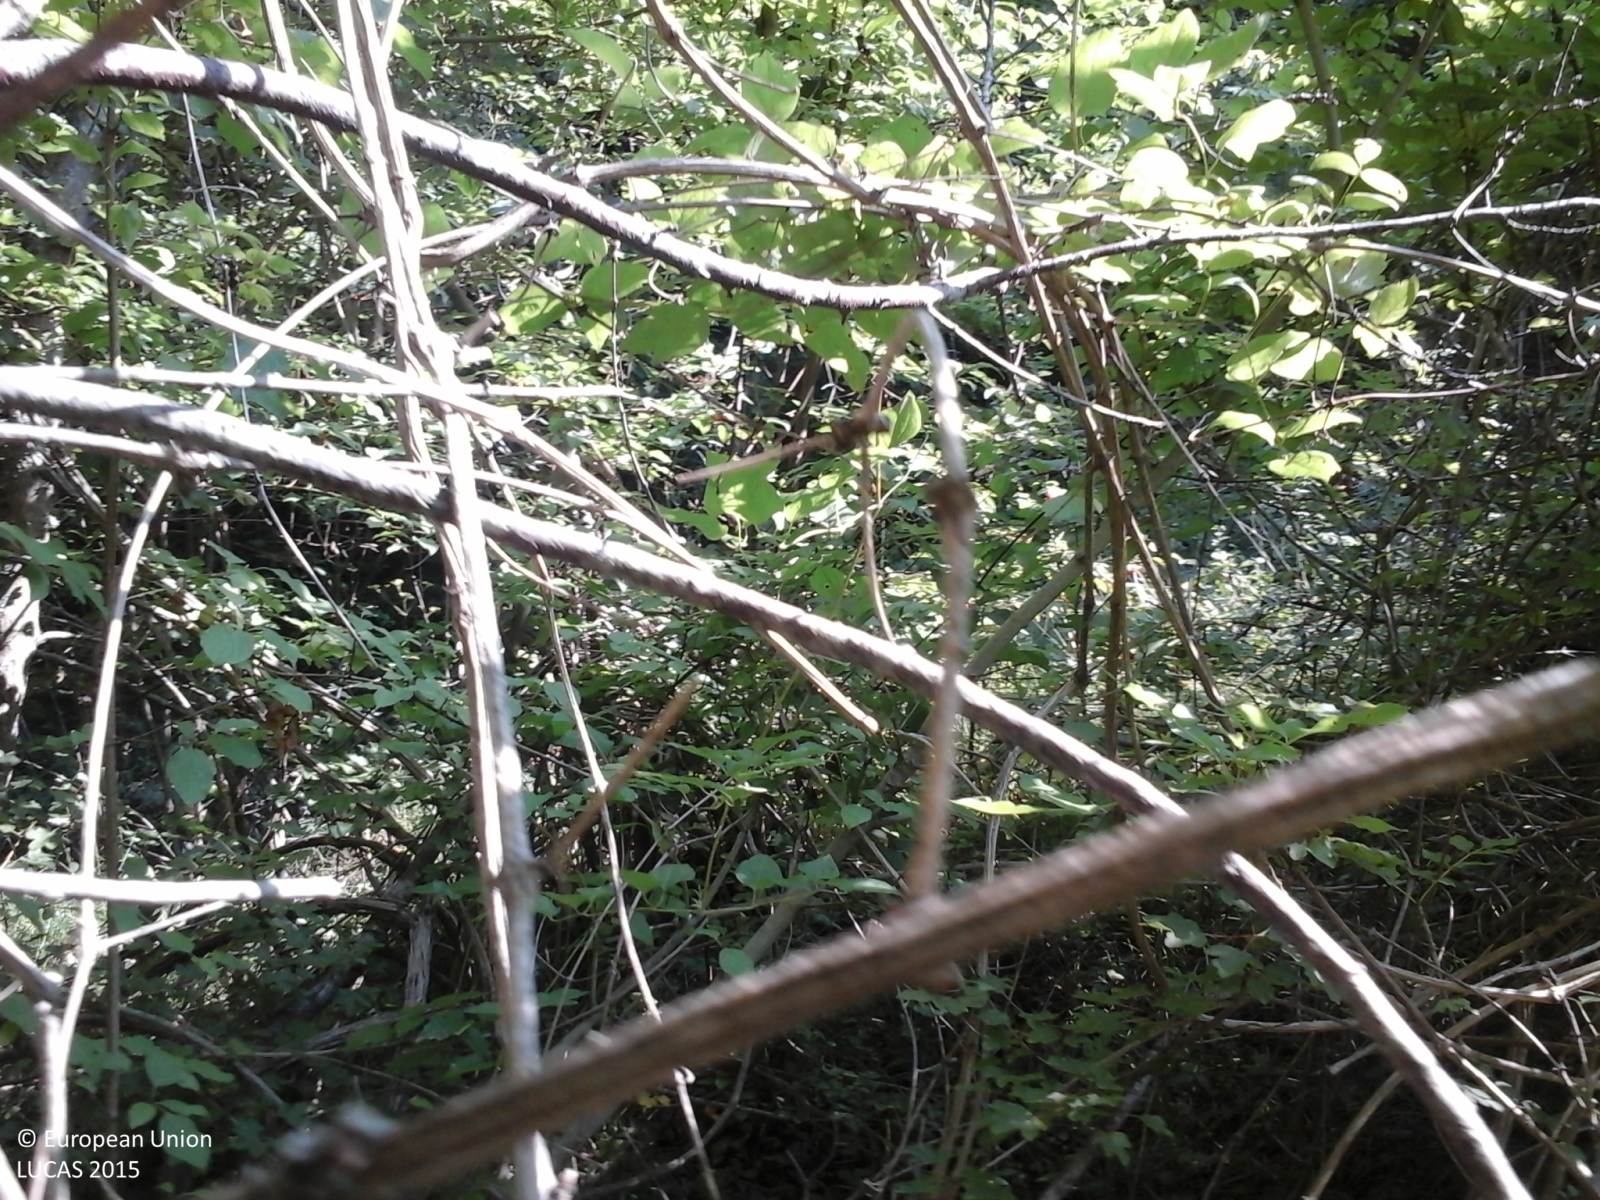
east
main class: Woodland
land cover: Broadleaved woodland
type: thermophilous deciduous forest
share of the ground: > 75 %
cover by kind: broadleaved forest trees 100 %
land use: Forestry
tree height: > 5 m
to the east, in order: Broadleaved woodland
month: August
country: IT
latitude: 43.6204
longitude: 12.3361
